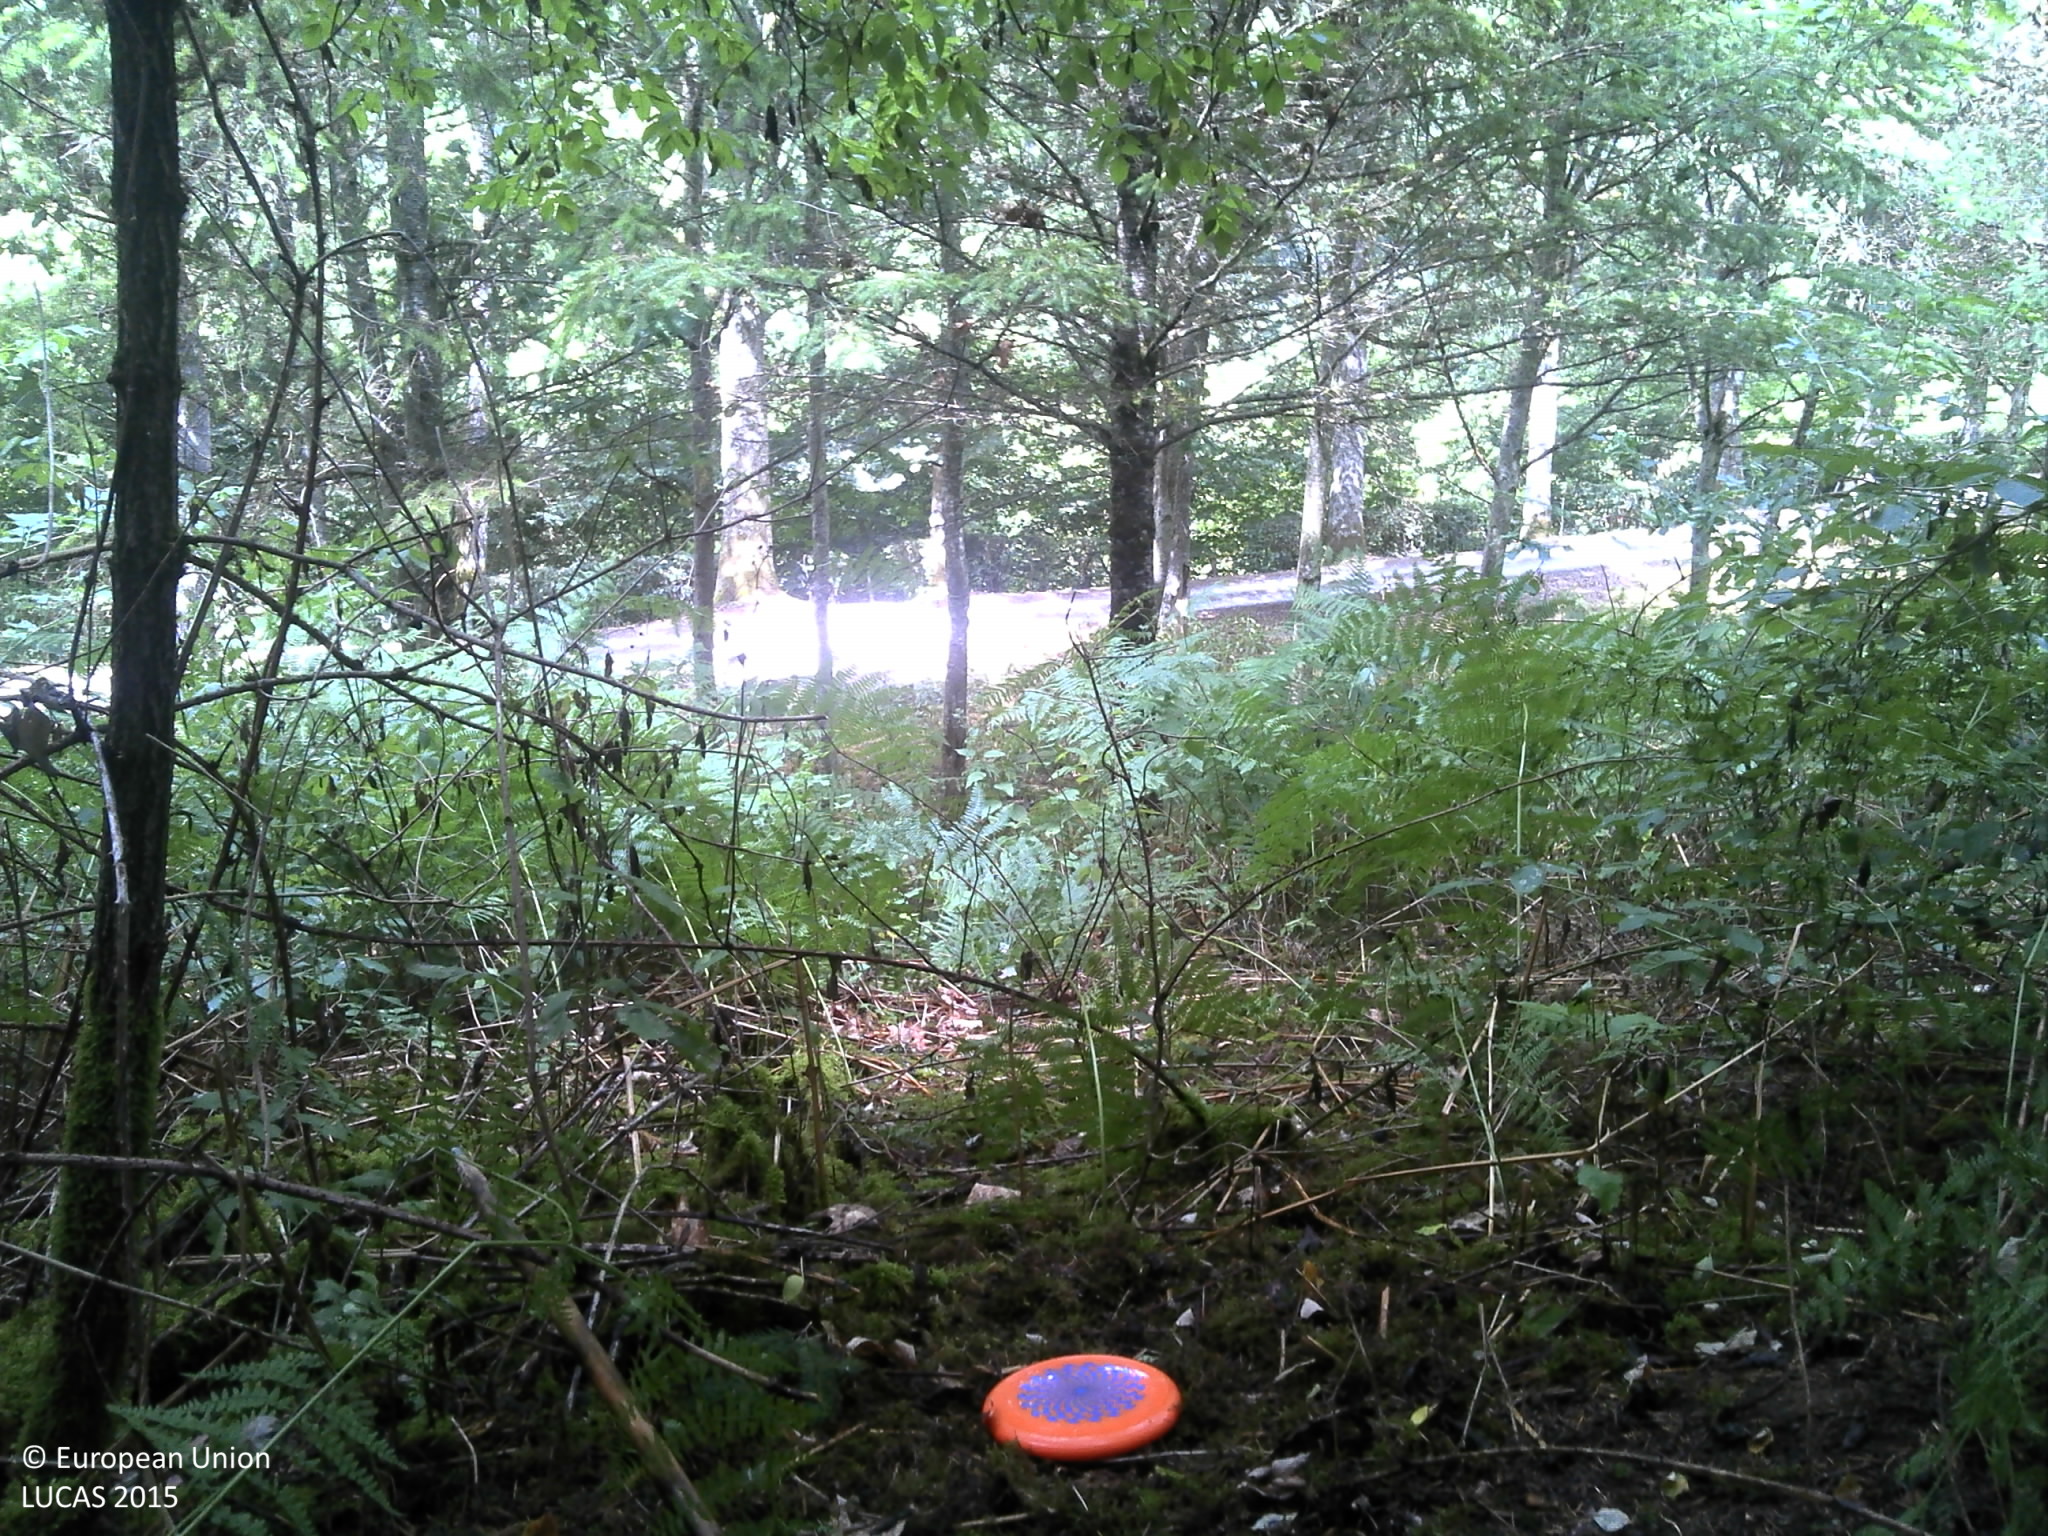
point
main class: Woodland
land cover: Other mixed woodland
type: mountainous beech forest
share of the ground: > 75 %
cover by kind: coniferous forest trees 40 %, broadleaved forest trees 20 %, herbaceous plants 20 %, lichens and mosses 20 %
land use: Forestry
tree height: > 5 m
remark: Nursery
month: August
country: FR
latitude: 45.5165
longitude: 2.3554
